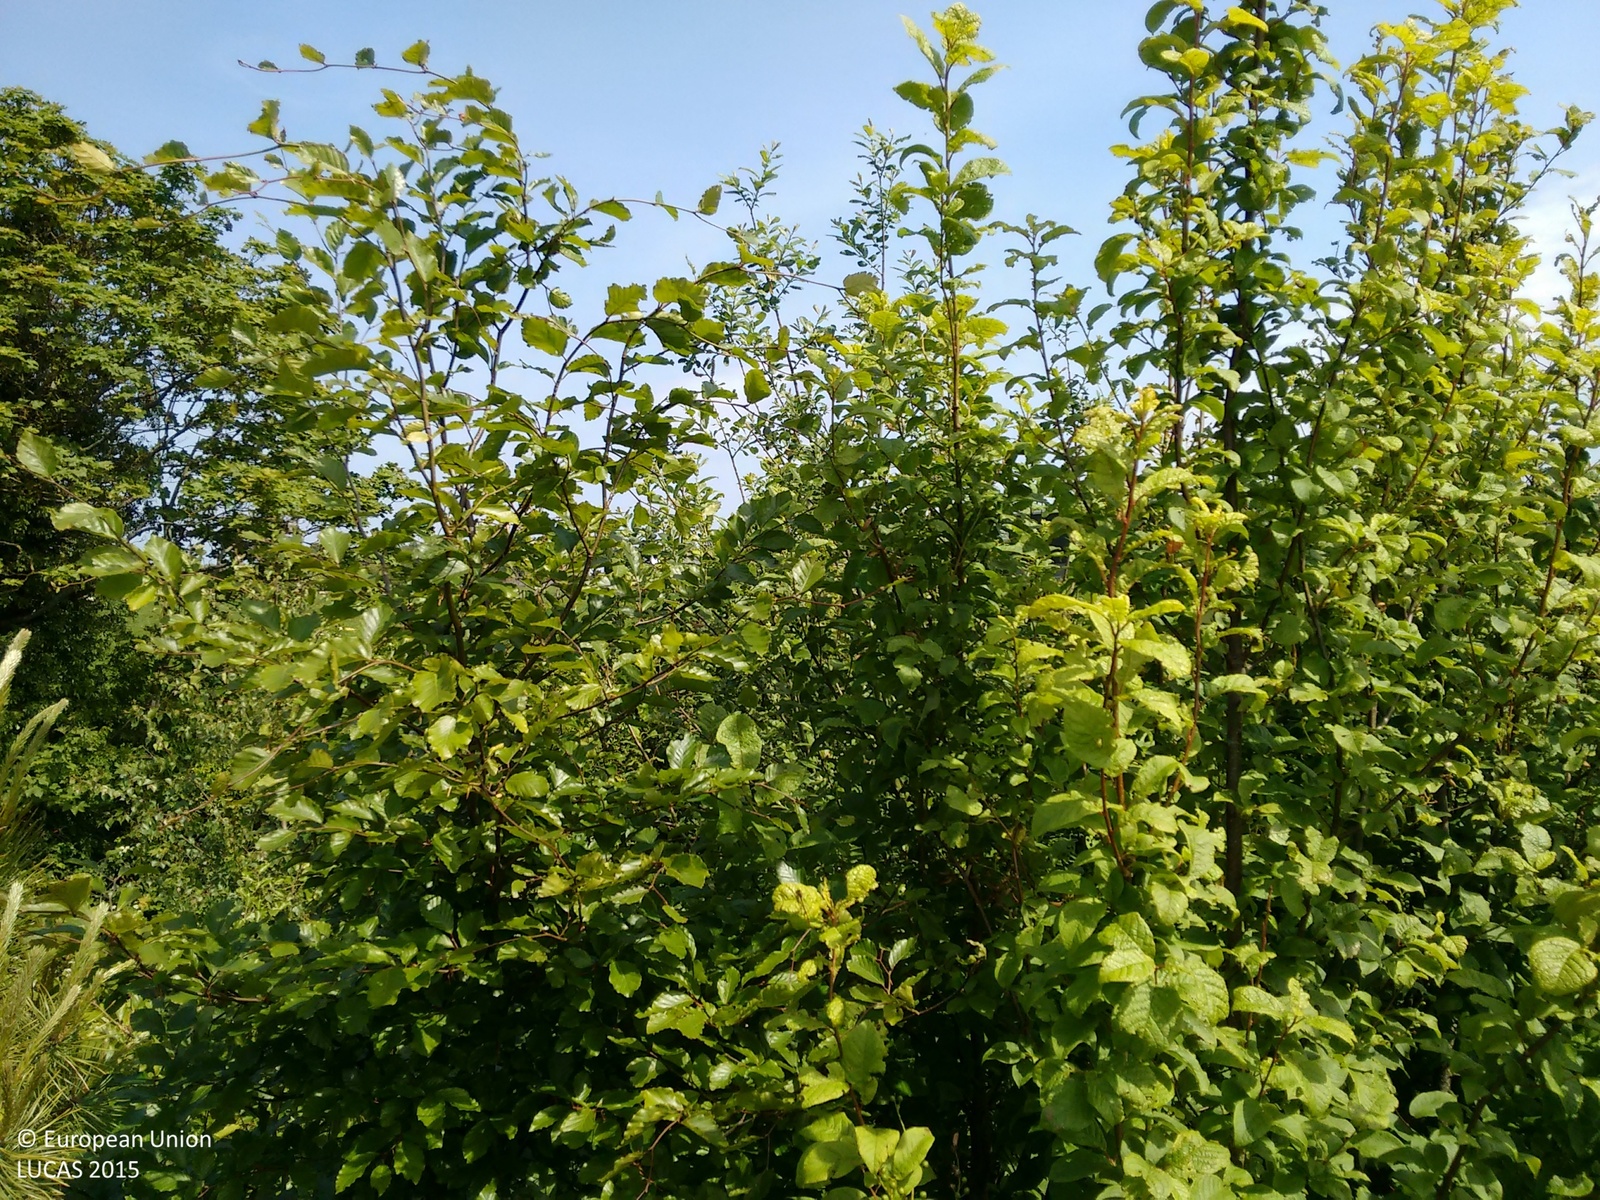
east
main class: Woodland
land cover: Broadleaved woodland
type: acidophilous oak and oak-birch forest
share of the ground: > 75 %
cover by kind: broadleaved forest trees 90 %, coniferous forest trees 10 %
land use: Road transport
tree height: < 5 m
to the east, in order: Broadleaved woodland; Artificial constructions in urban areas; Grassland without tree/shrub cover; Fences; Grassland without tree/shrub cover; Paved roads, cycling and walking lanes
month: June
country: IE
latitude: 53.5716
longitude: -6.5736
